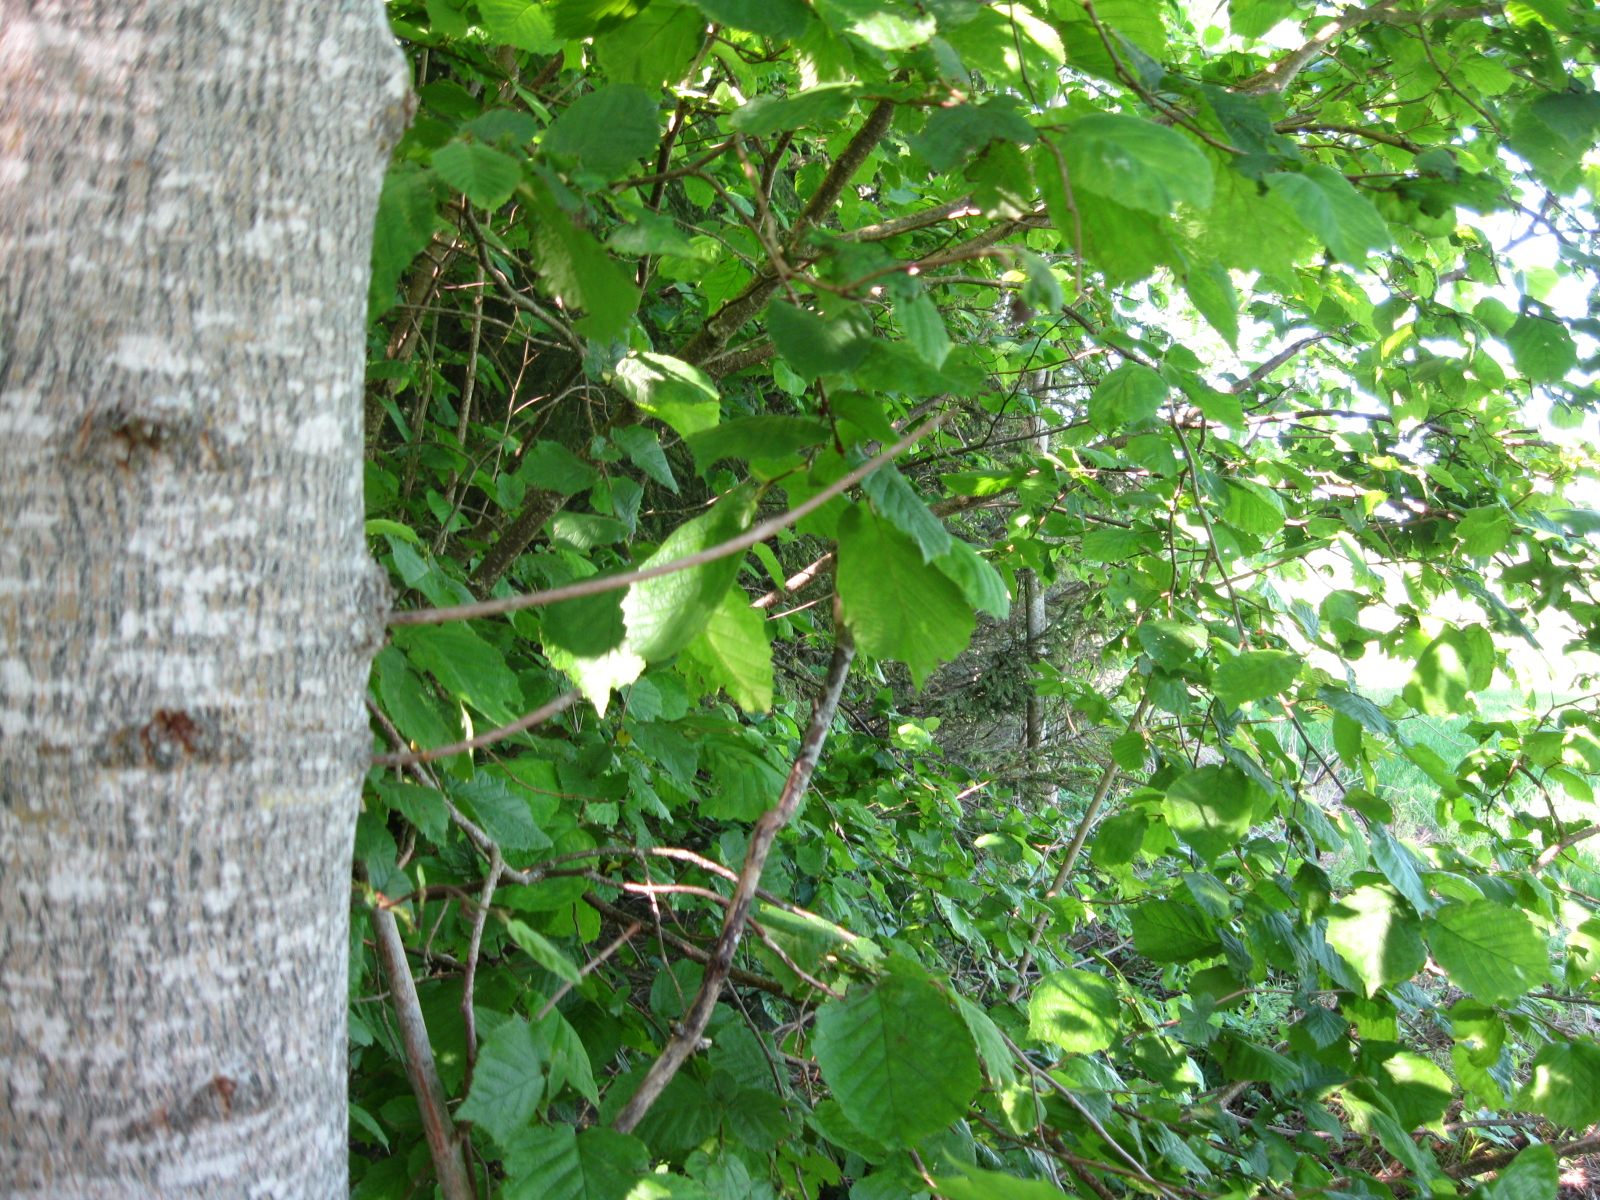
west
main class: Woodland
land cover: Broadleaved woodland
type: non-riverine alder, birch or aspen forest
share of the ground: > 75 %
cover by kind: broadleaved forest trees 80 %, coniferous forest trees 10 %, herbaceous plants 10 %
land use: Forestry
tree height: > 5 m
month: June
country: LT
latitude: 55.9198
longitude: 23.7314
